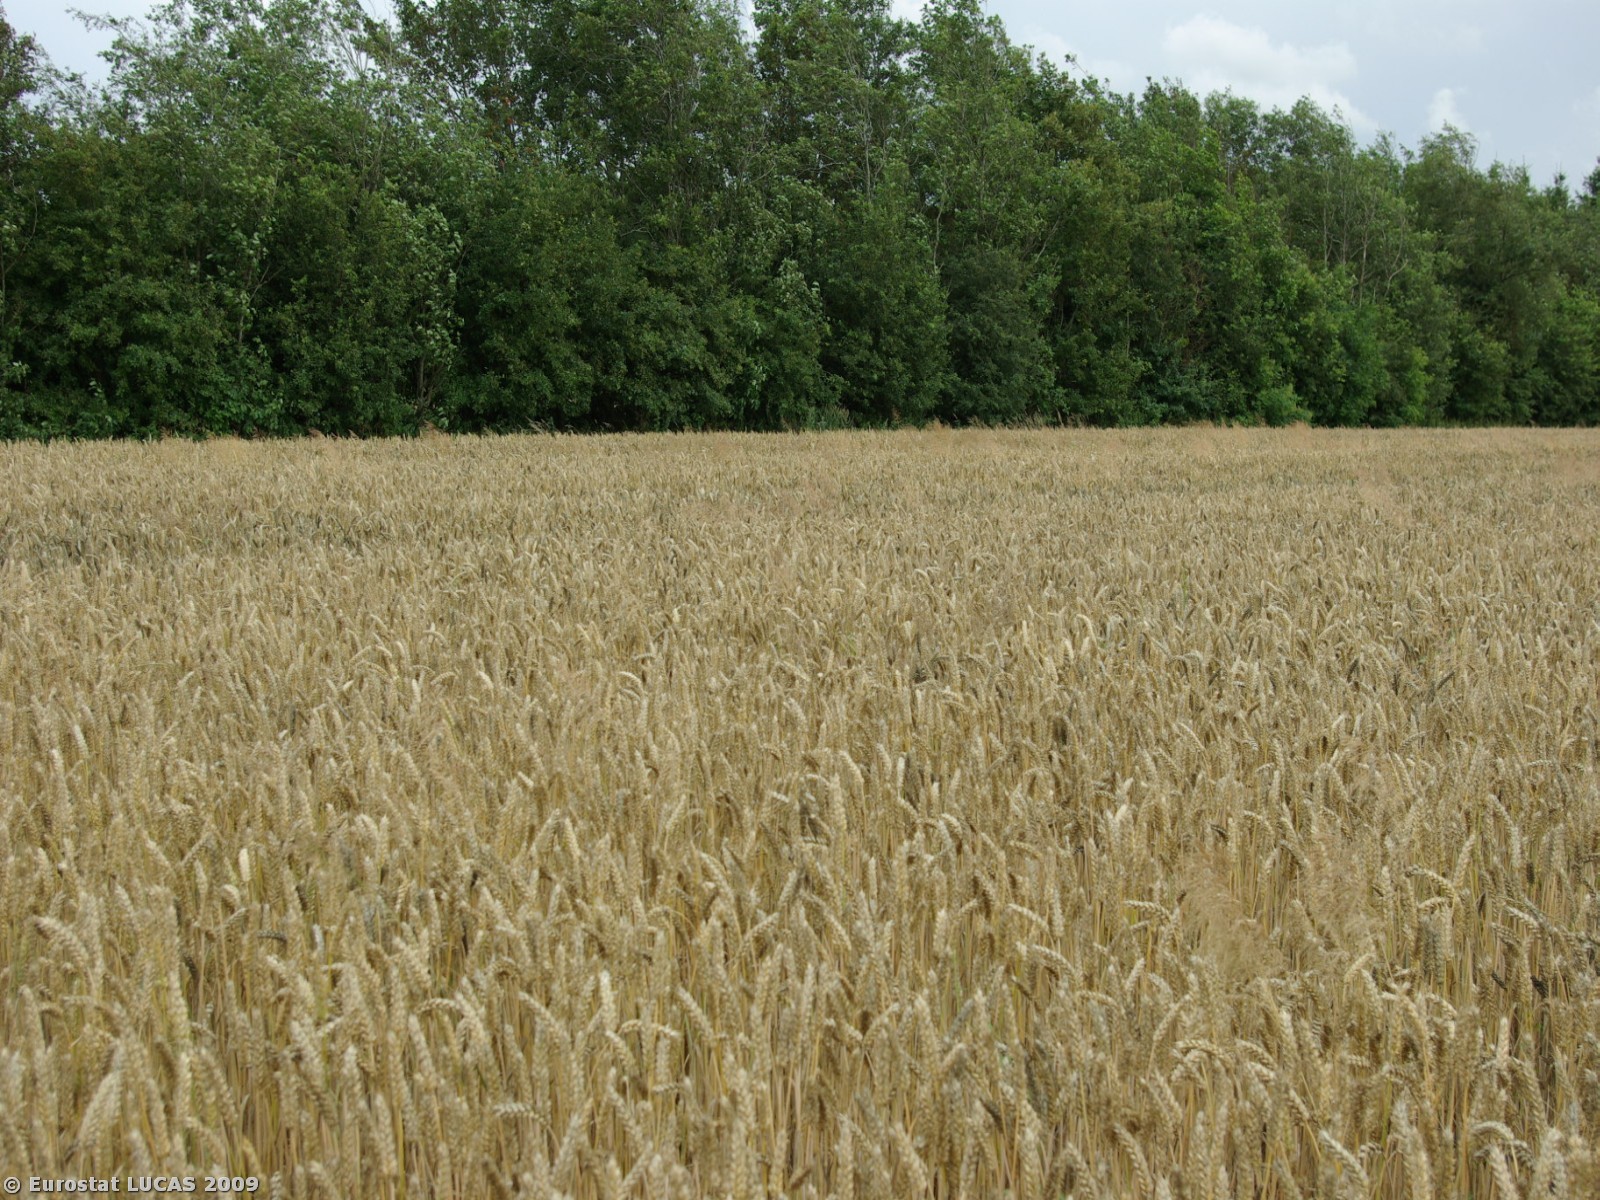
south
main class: Cropland
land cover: Common wheat
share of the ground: > 75 %
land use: Agriculture (excluding fallow land and kitchen gardens)
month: July
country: DK
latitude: 55.0335
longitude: 9.0151
